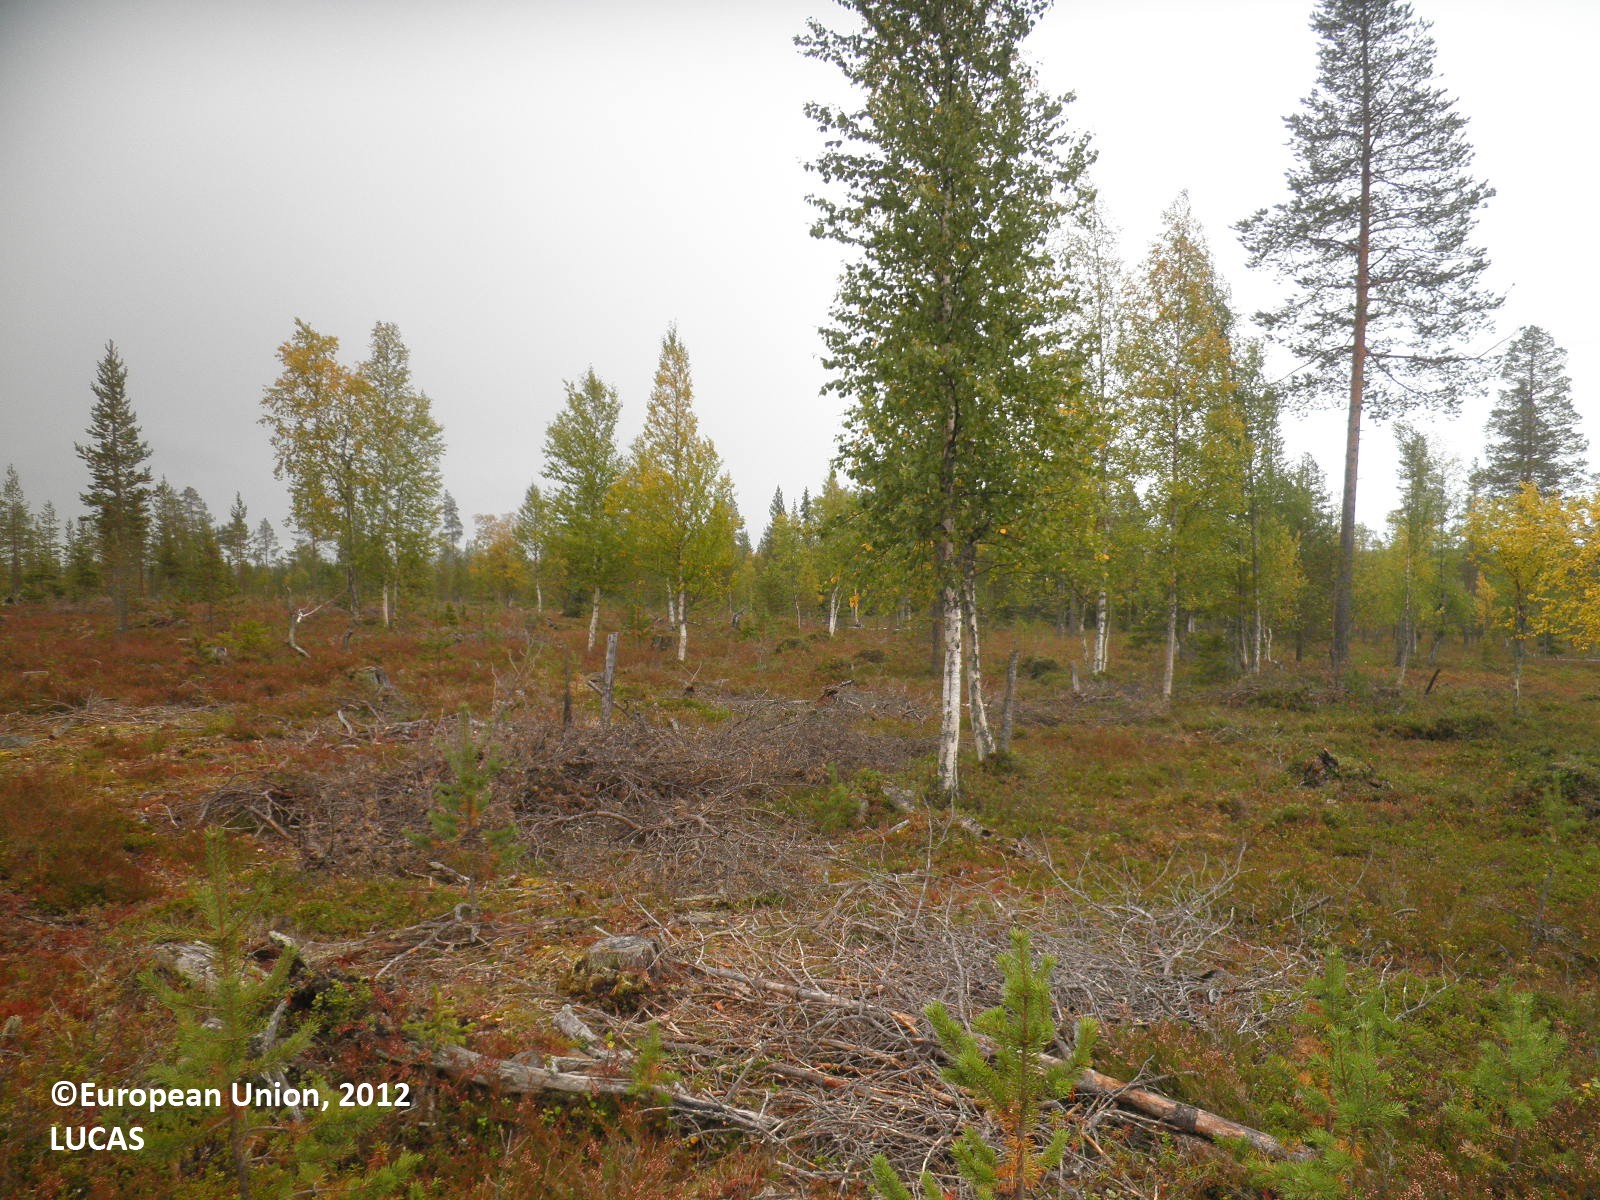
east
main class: Shrubland
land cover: Shrubland with sparse tree cover
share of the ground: > 75 %
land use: Forestry
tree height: > 5 m
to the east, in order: Shrubland with sparse tree cover; Pine dominated mixed woodland; Shrubland with sparse tree cover; Pine dominated mixed woodland; Pine dominated coniferous woodland
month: September
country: FI
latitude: 67.4180
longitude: 28.4469
